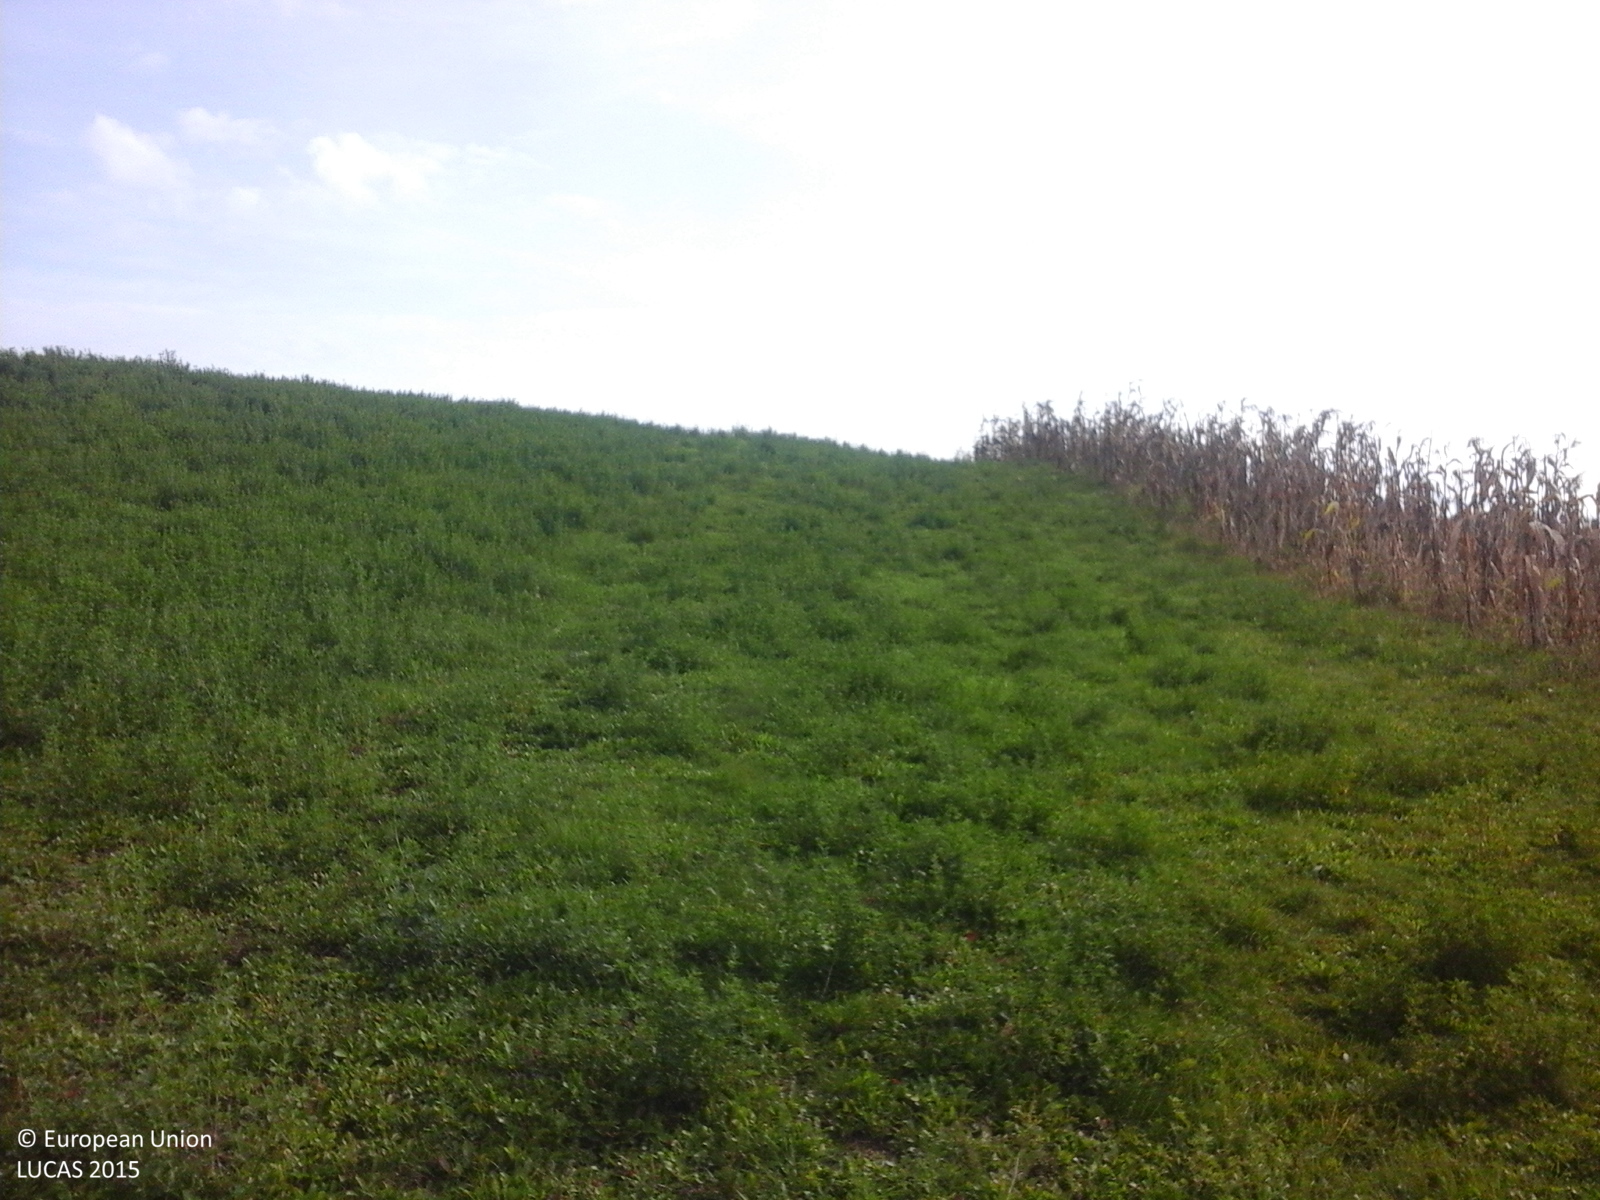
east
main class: Cropland
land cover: Lucerne
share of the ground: > 75 %
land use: Agriculture (excluding fallow land and kitchen gardens)
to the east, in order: Lucerne; Tracks; Lucerne; Common wheat; Tracks; Grass margins; Ditches and canals; Tracks; Ditches and canals
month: October
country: RO
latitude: 46.1991
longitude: 25.1438
